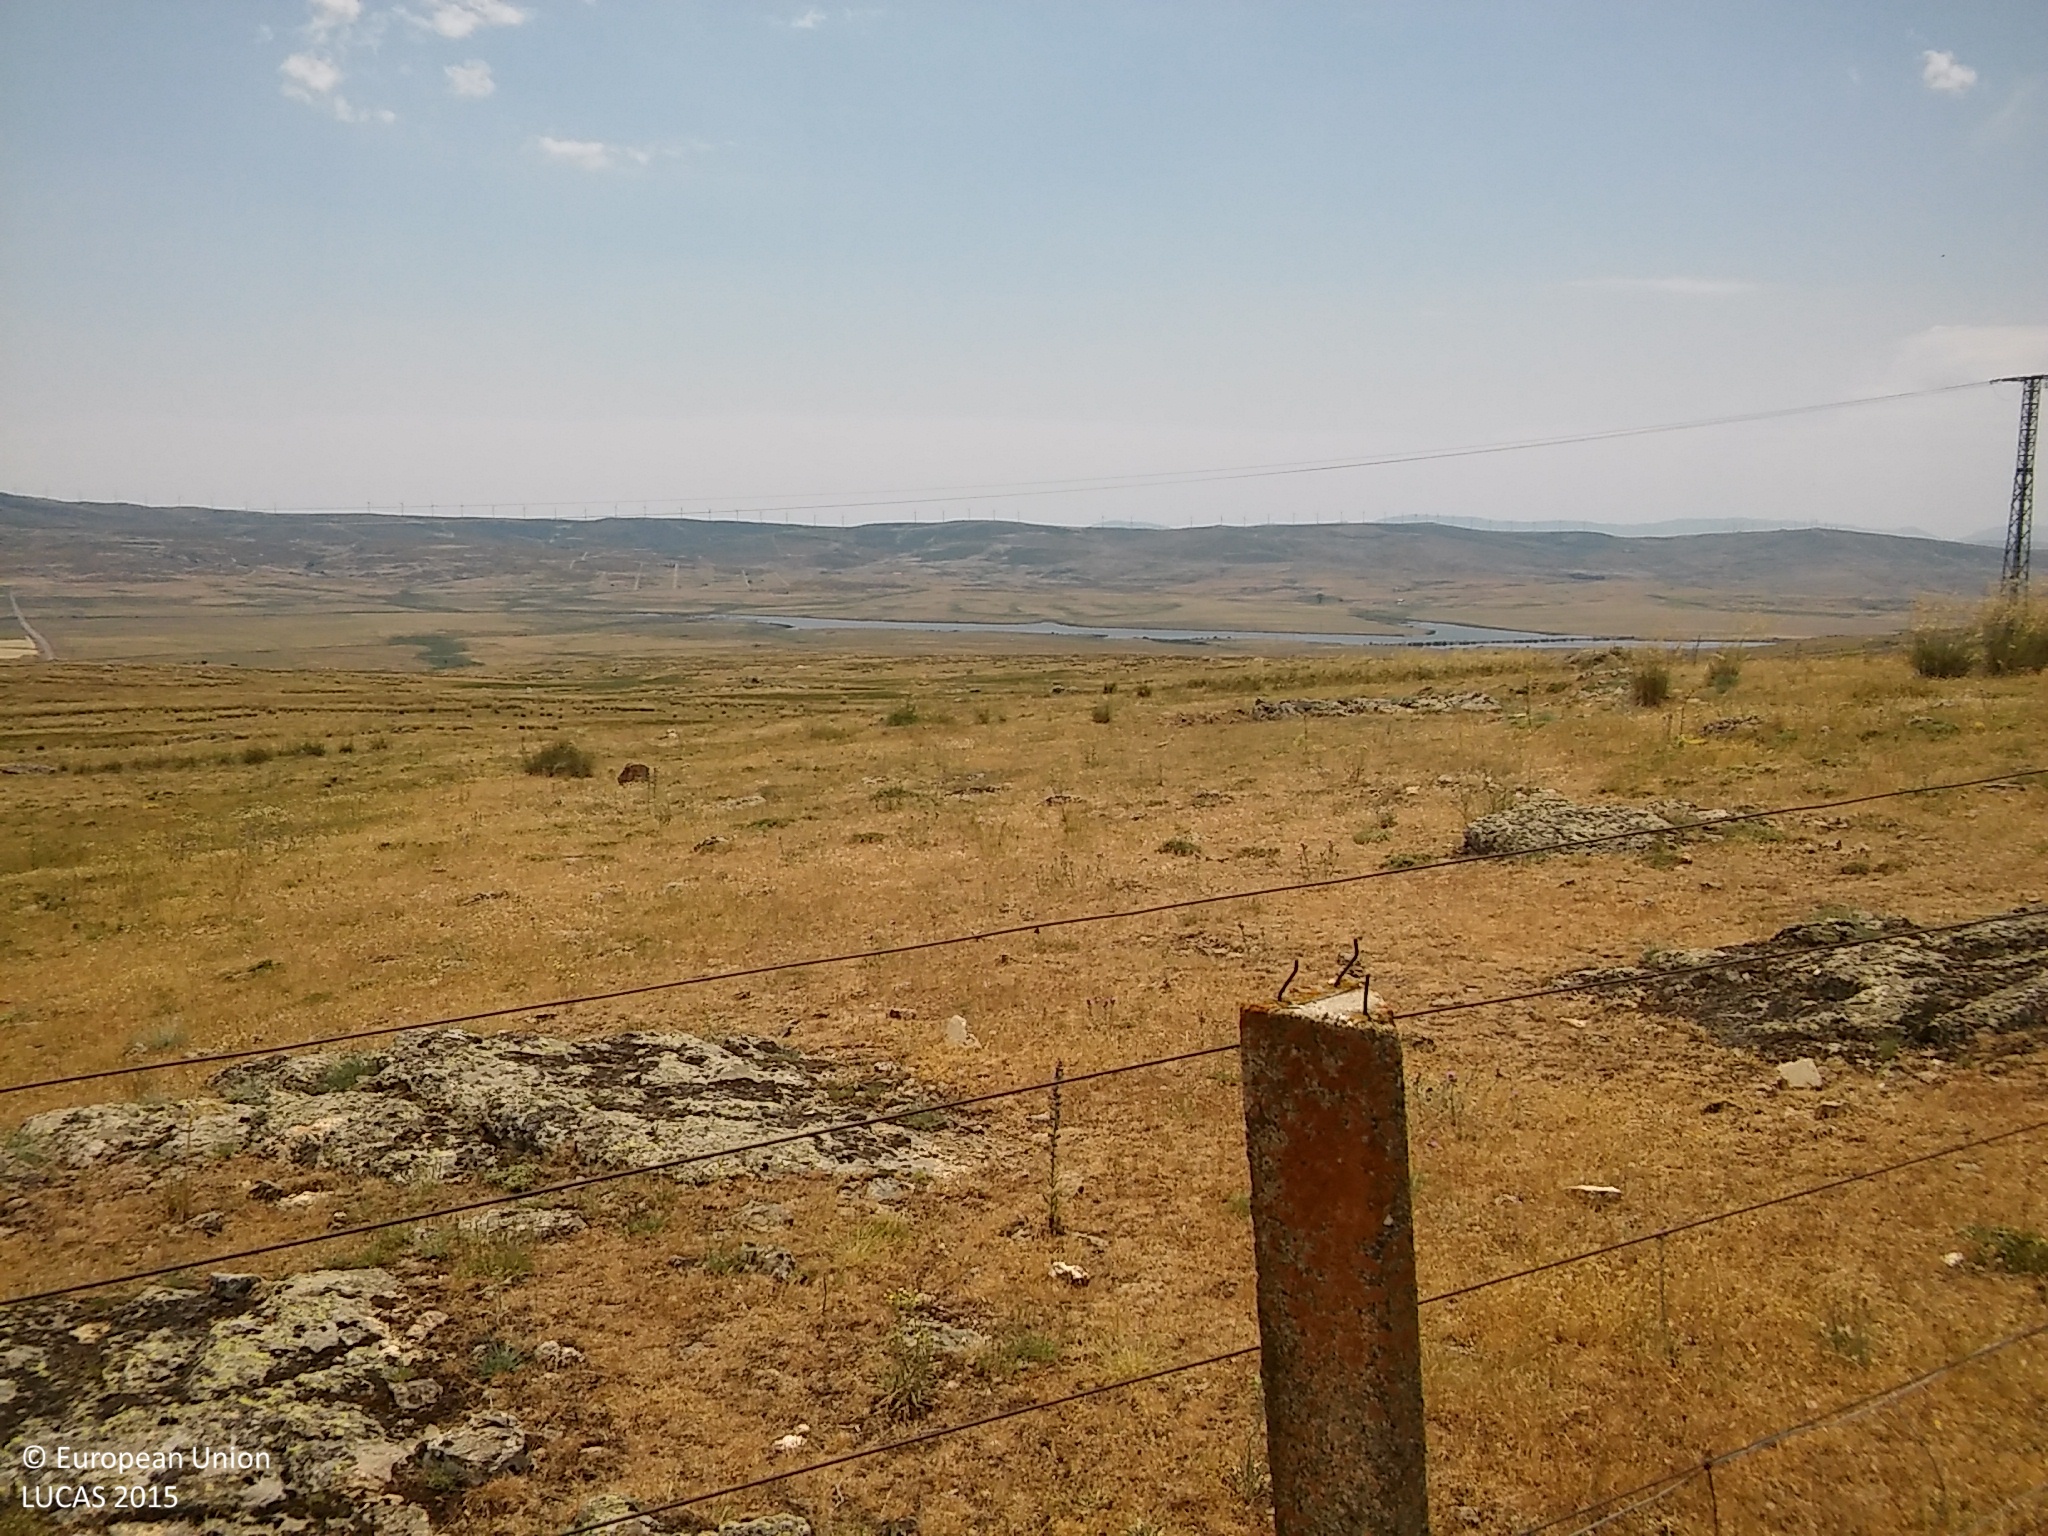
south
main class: Grassland
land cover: Grassland without tree/shrub cover
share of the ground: > 75 %
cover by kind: herbaceous plants 90 %, shrubs 5 %, consolidated bare surface 5 %
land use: Agriculture (excluding fallow land and kitchen gardens)
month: June
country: ES
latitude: 40.7159
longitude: -4.4350
